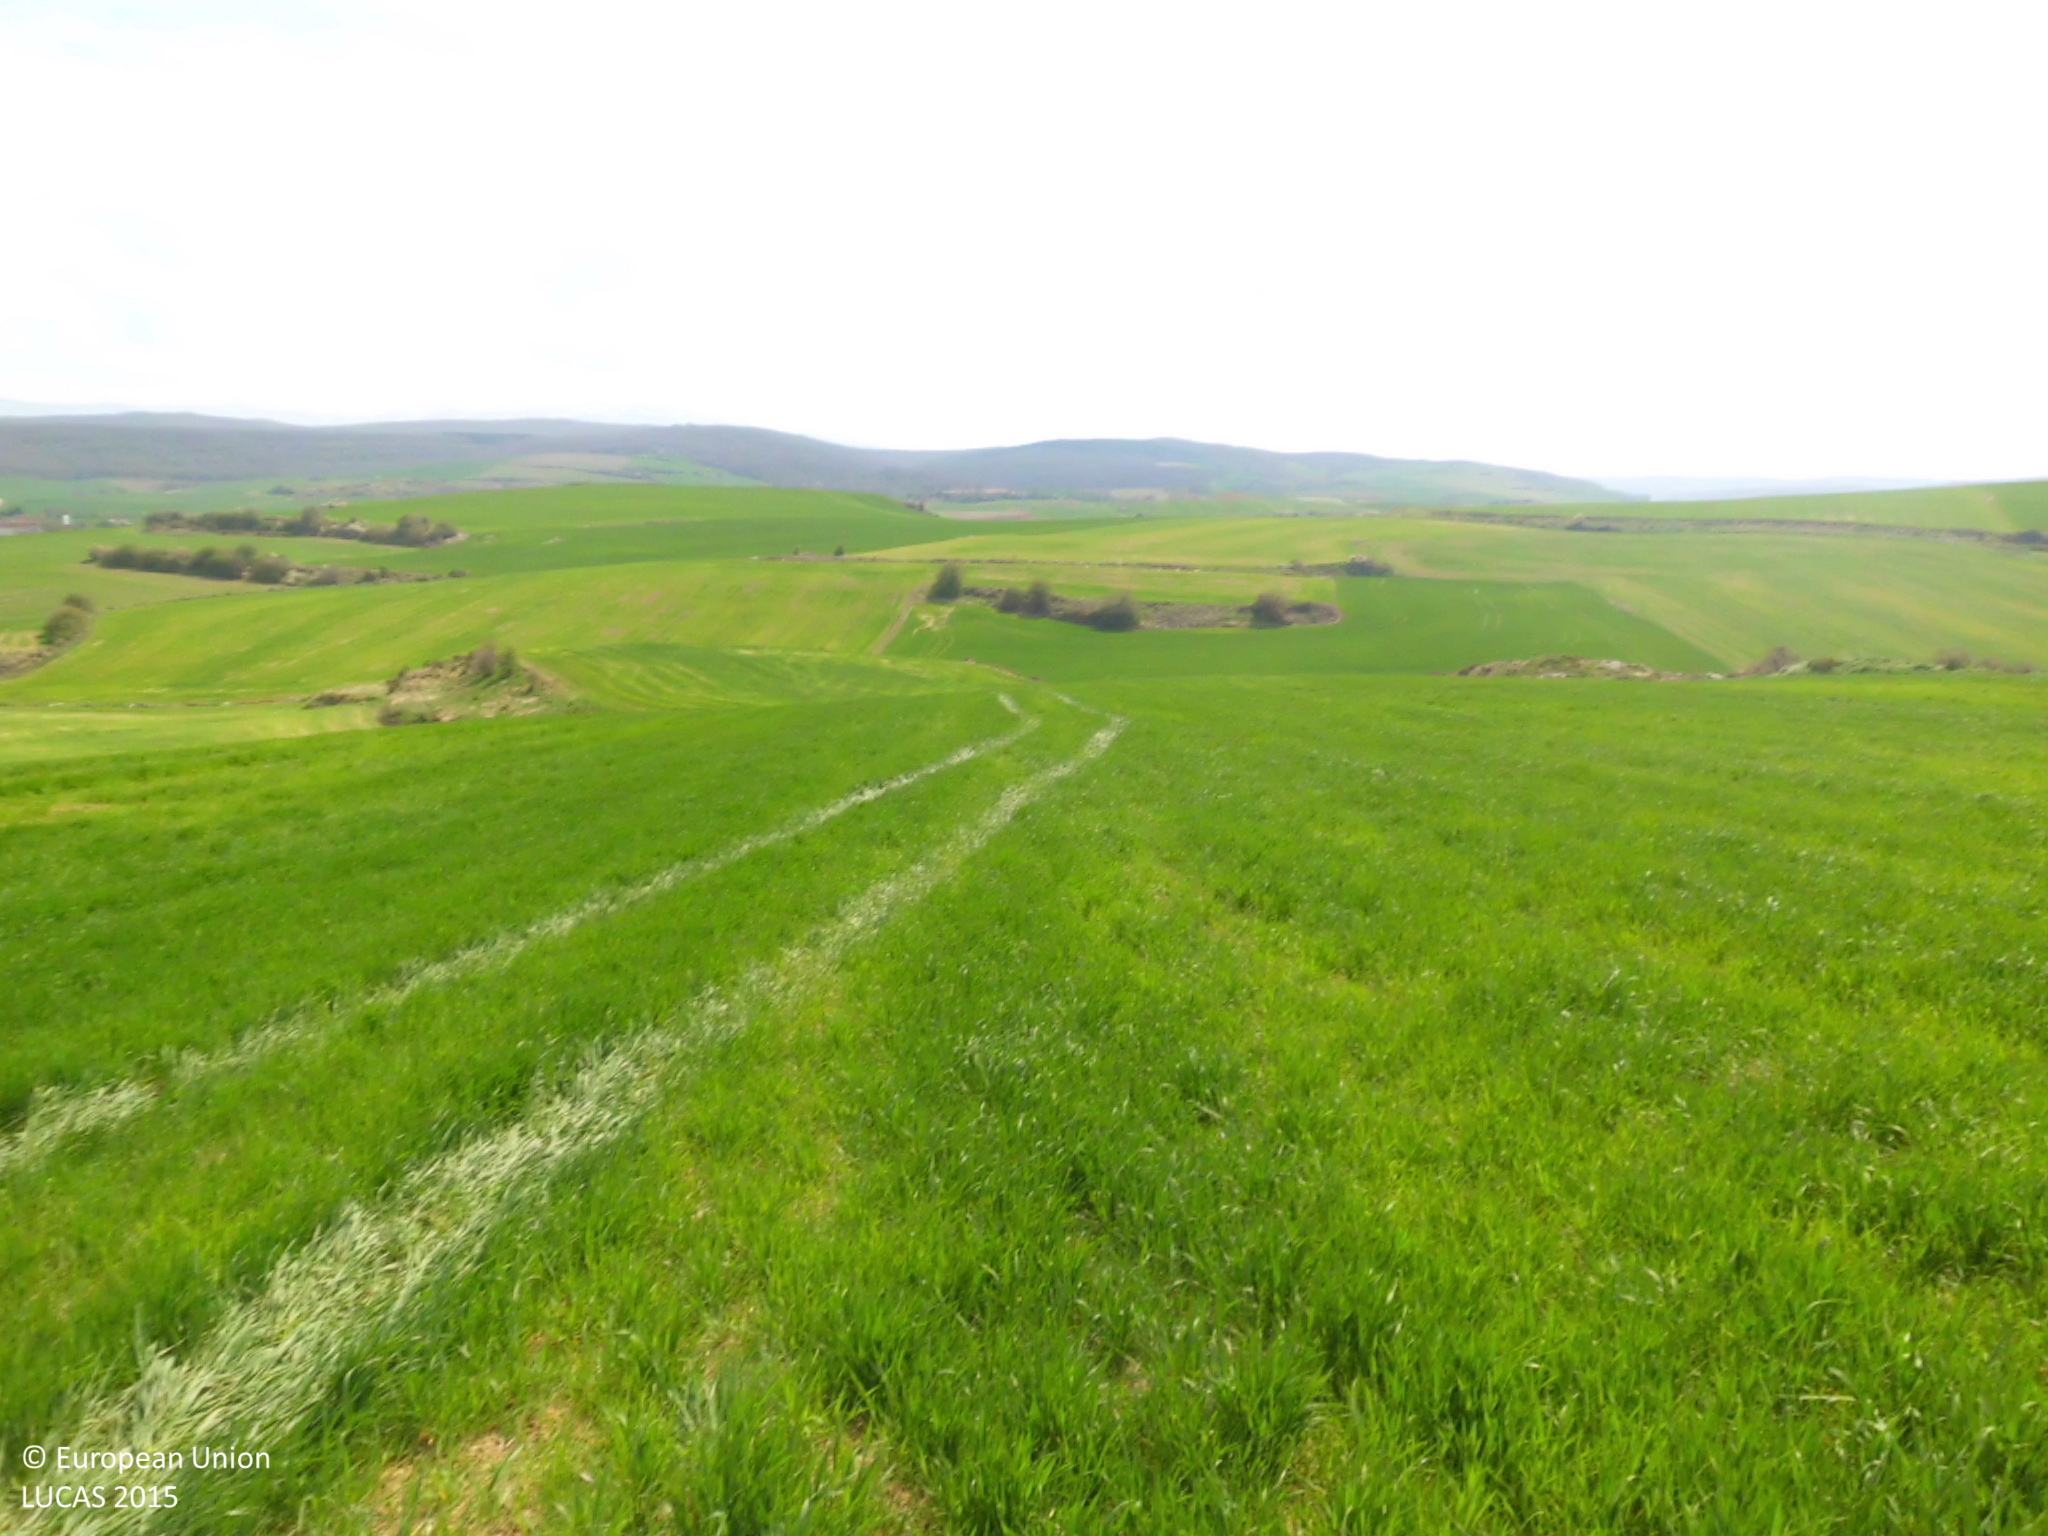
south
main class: Cropland
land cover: Barley
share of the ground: > 75 %
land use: Agriculture (excluding fallow land and kitchen gardens)
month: April
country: ES
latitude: 42.4138
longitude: -3.2886
